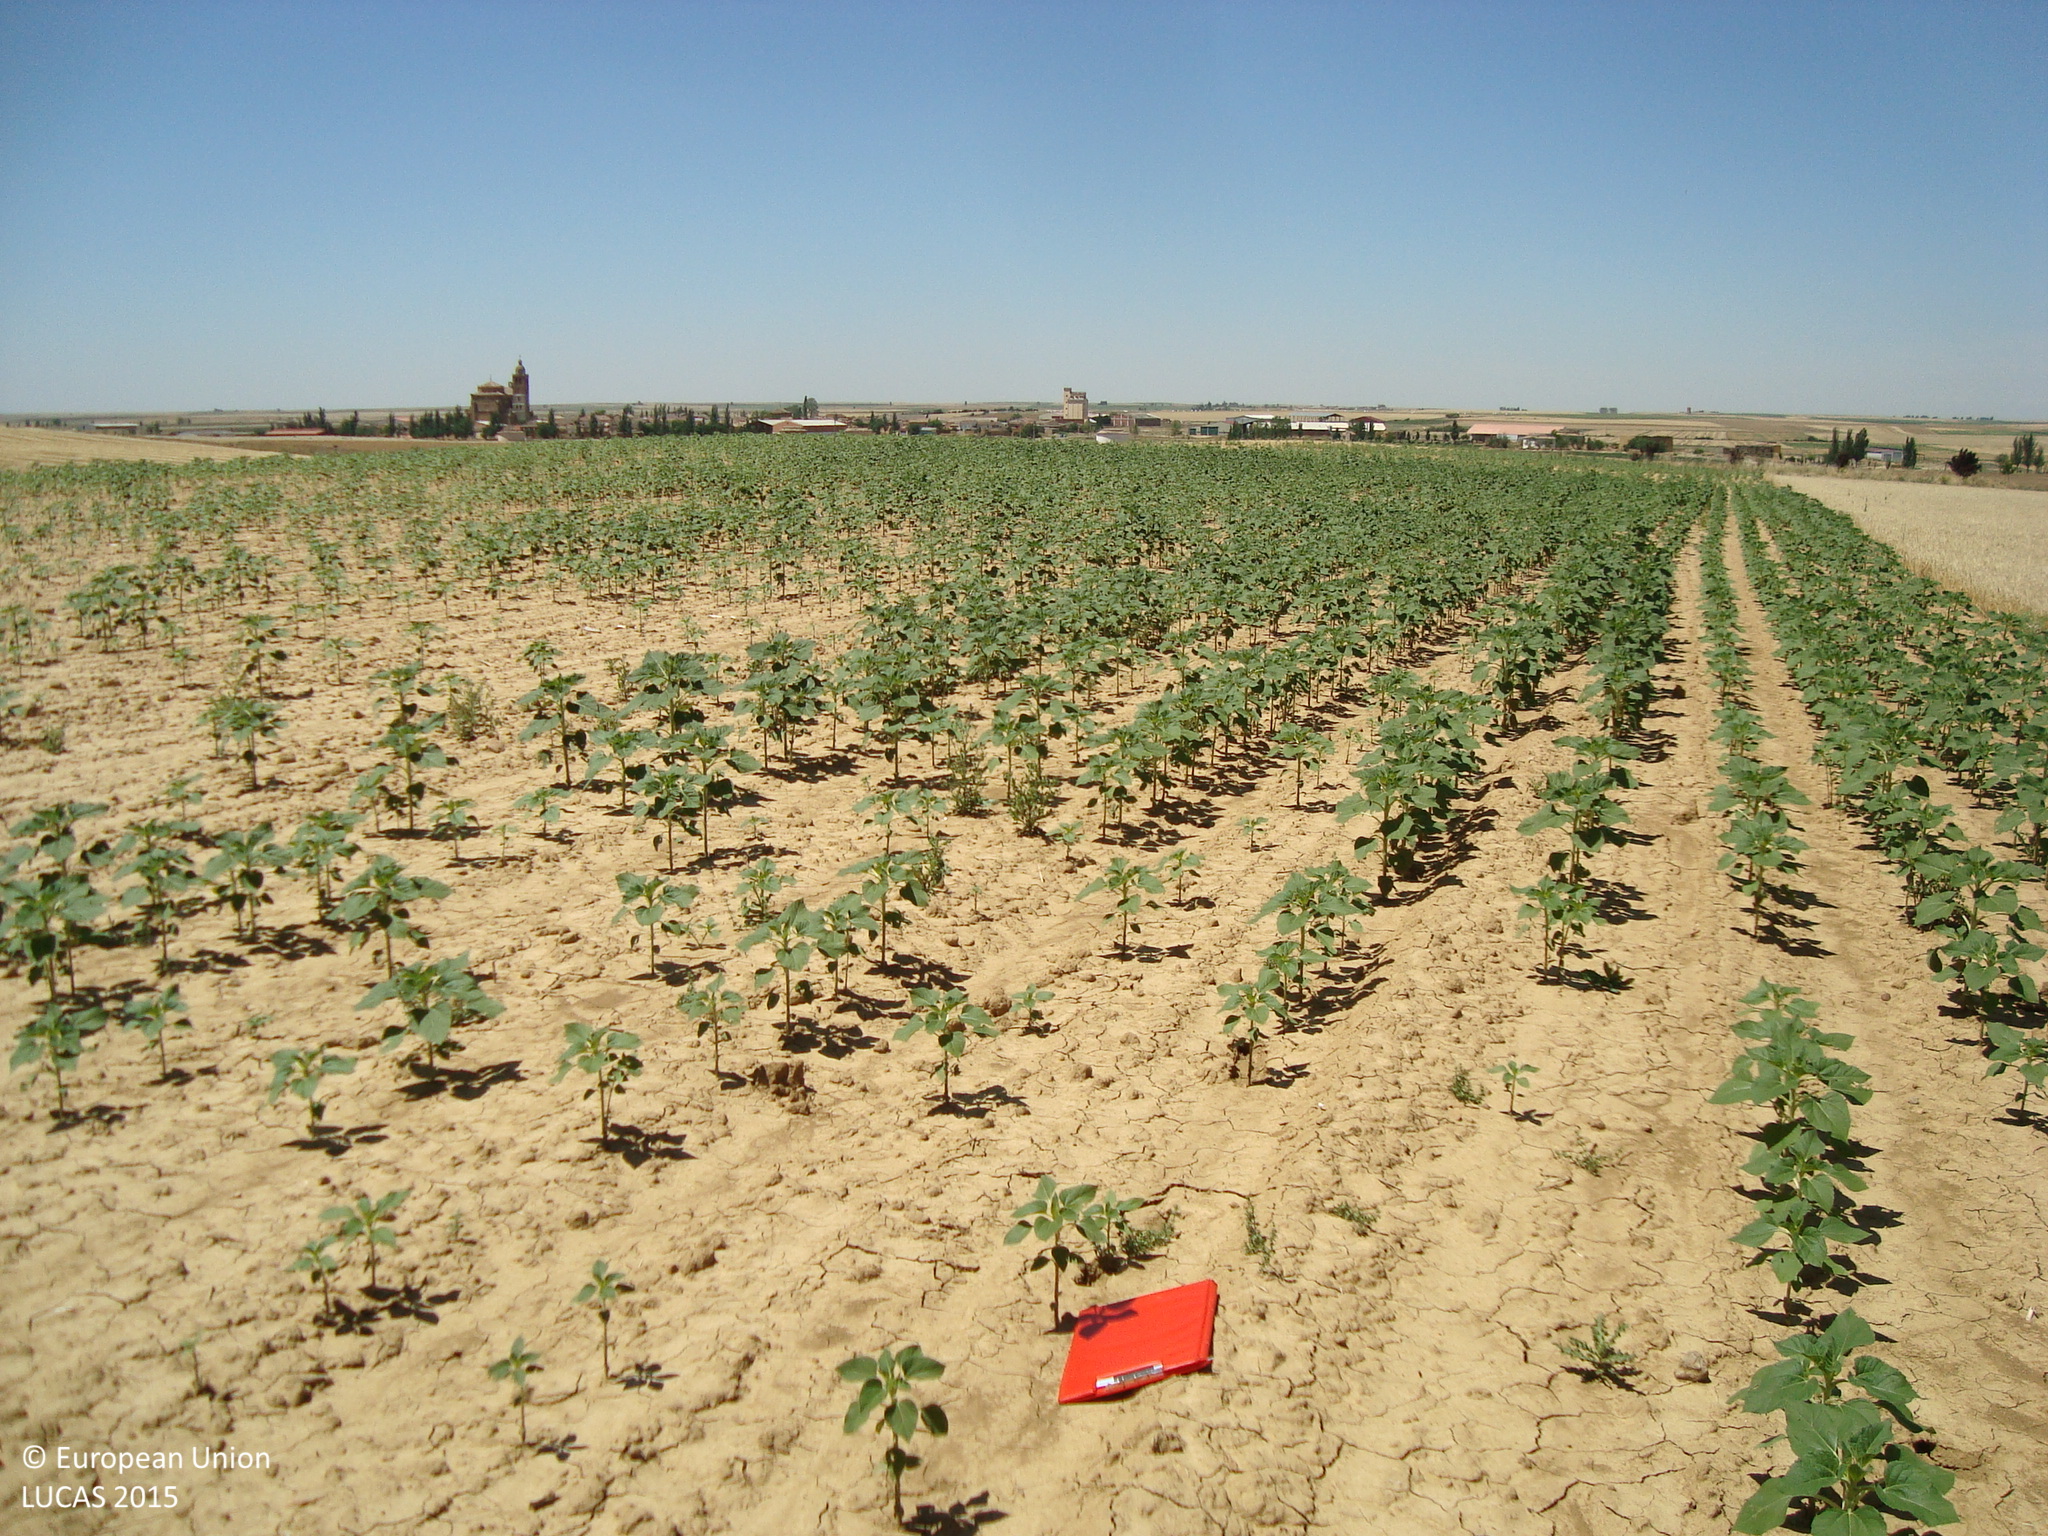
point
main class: Cropland
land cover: Sunflower
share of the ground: 25 - 50 %
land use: Agriculture (excluding fallow land and kitchen gardens)
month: July
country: ES
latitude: 42.1424
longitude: -4.8267
